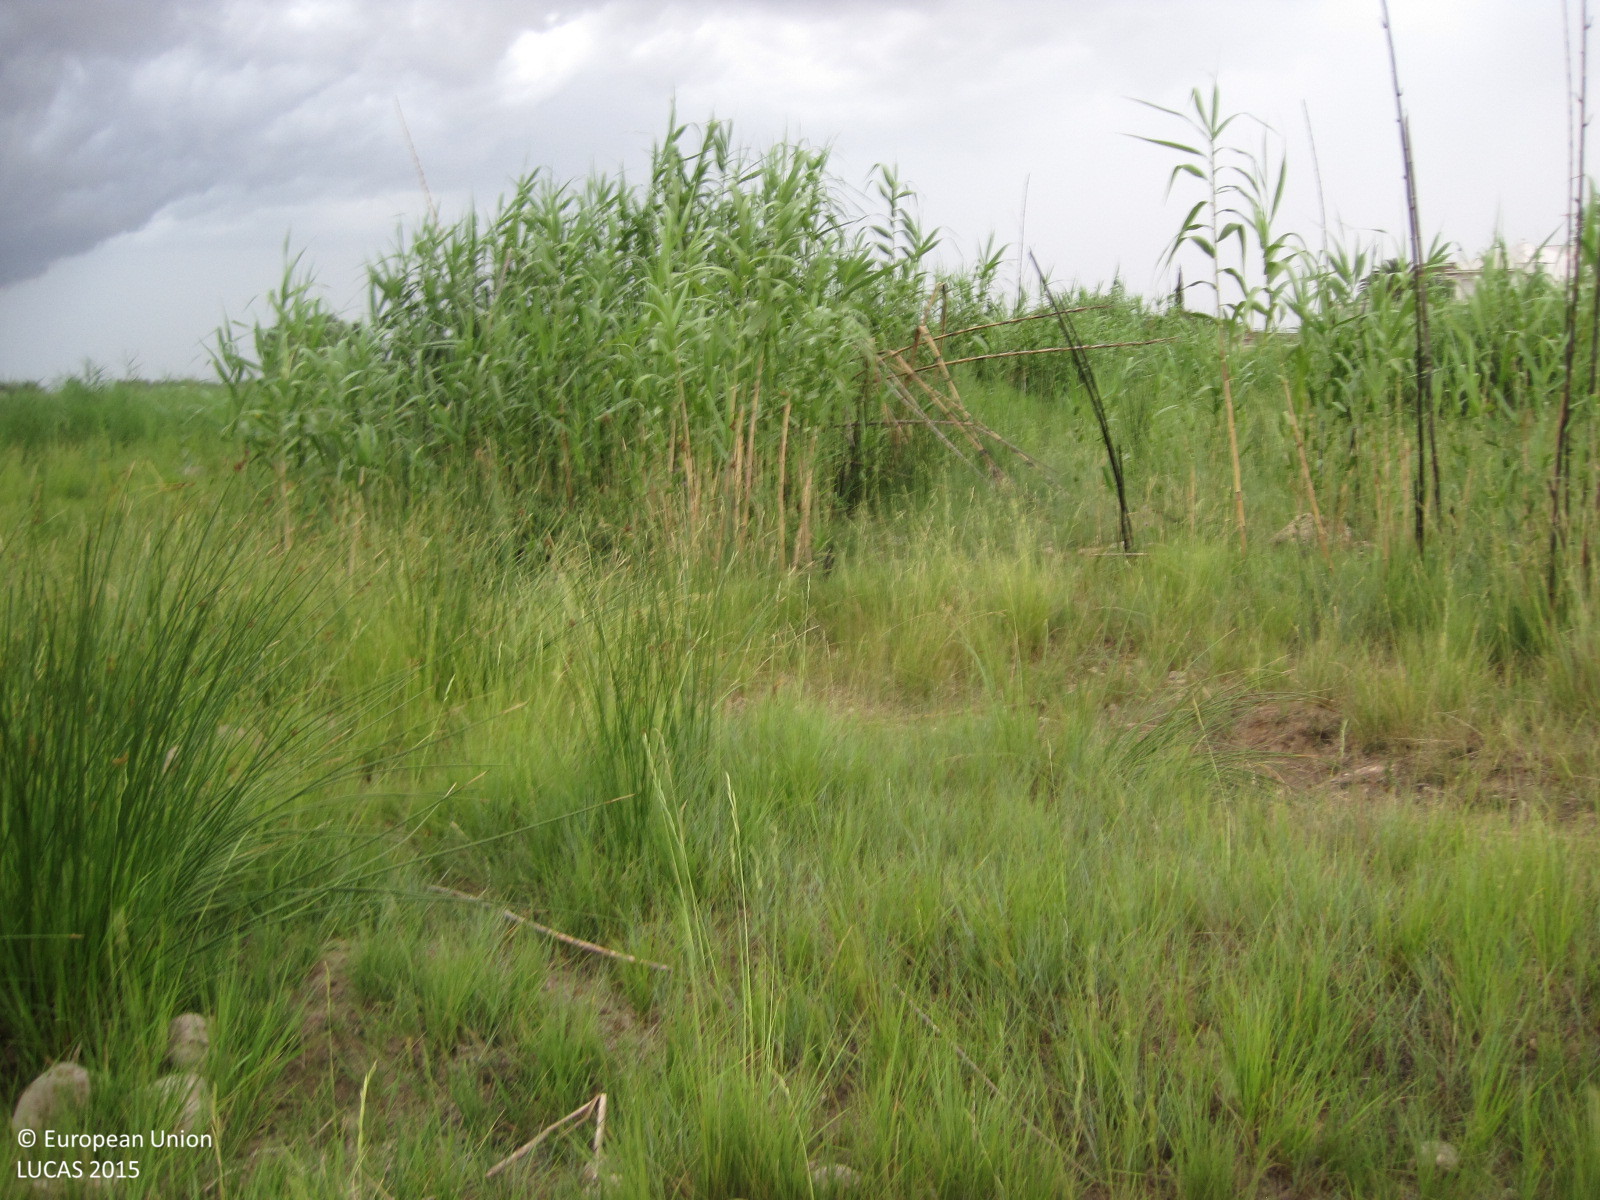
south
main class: Grassland
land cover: Grassland without tree/shrub cover
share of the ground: 50 - 75 %
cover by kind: herbaceous plants 70 %, unconsolidated bare surface 25 %, shrubs 5 %
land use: Semi-natural and natural areas not in use
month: June
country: ES
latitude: 39.2767
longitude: -0.5563
